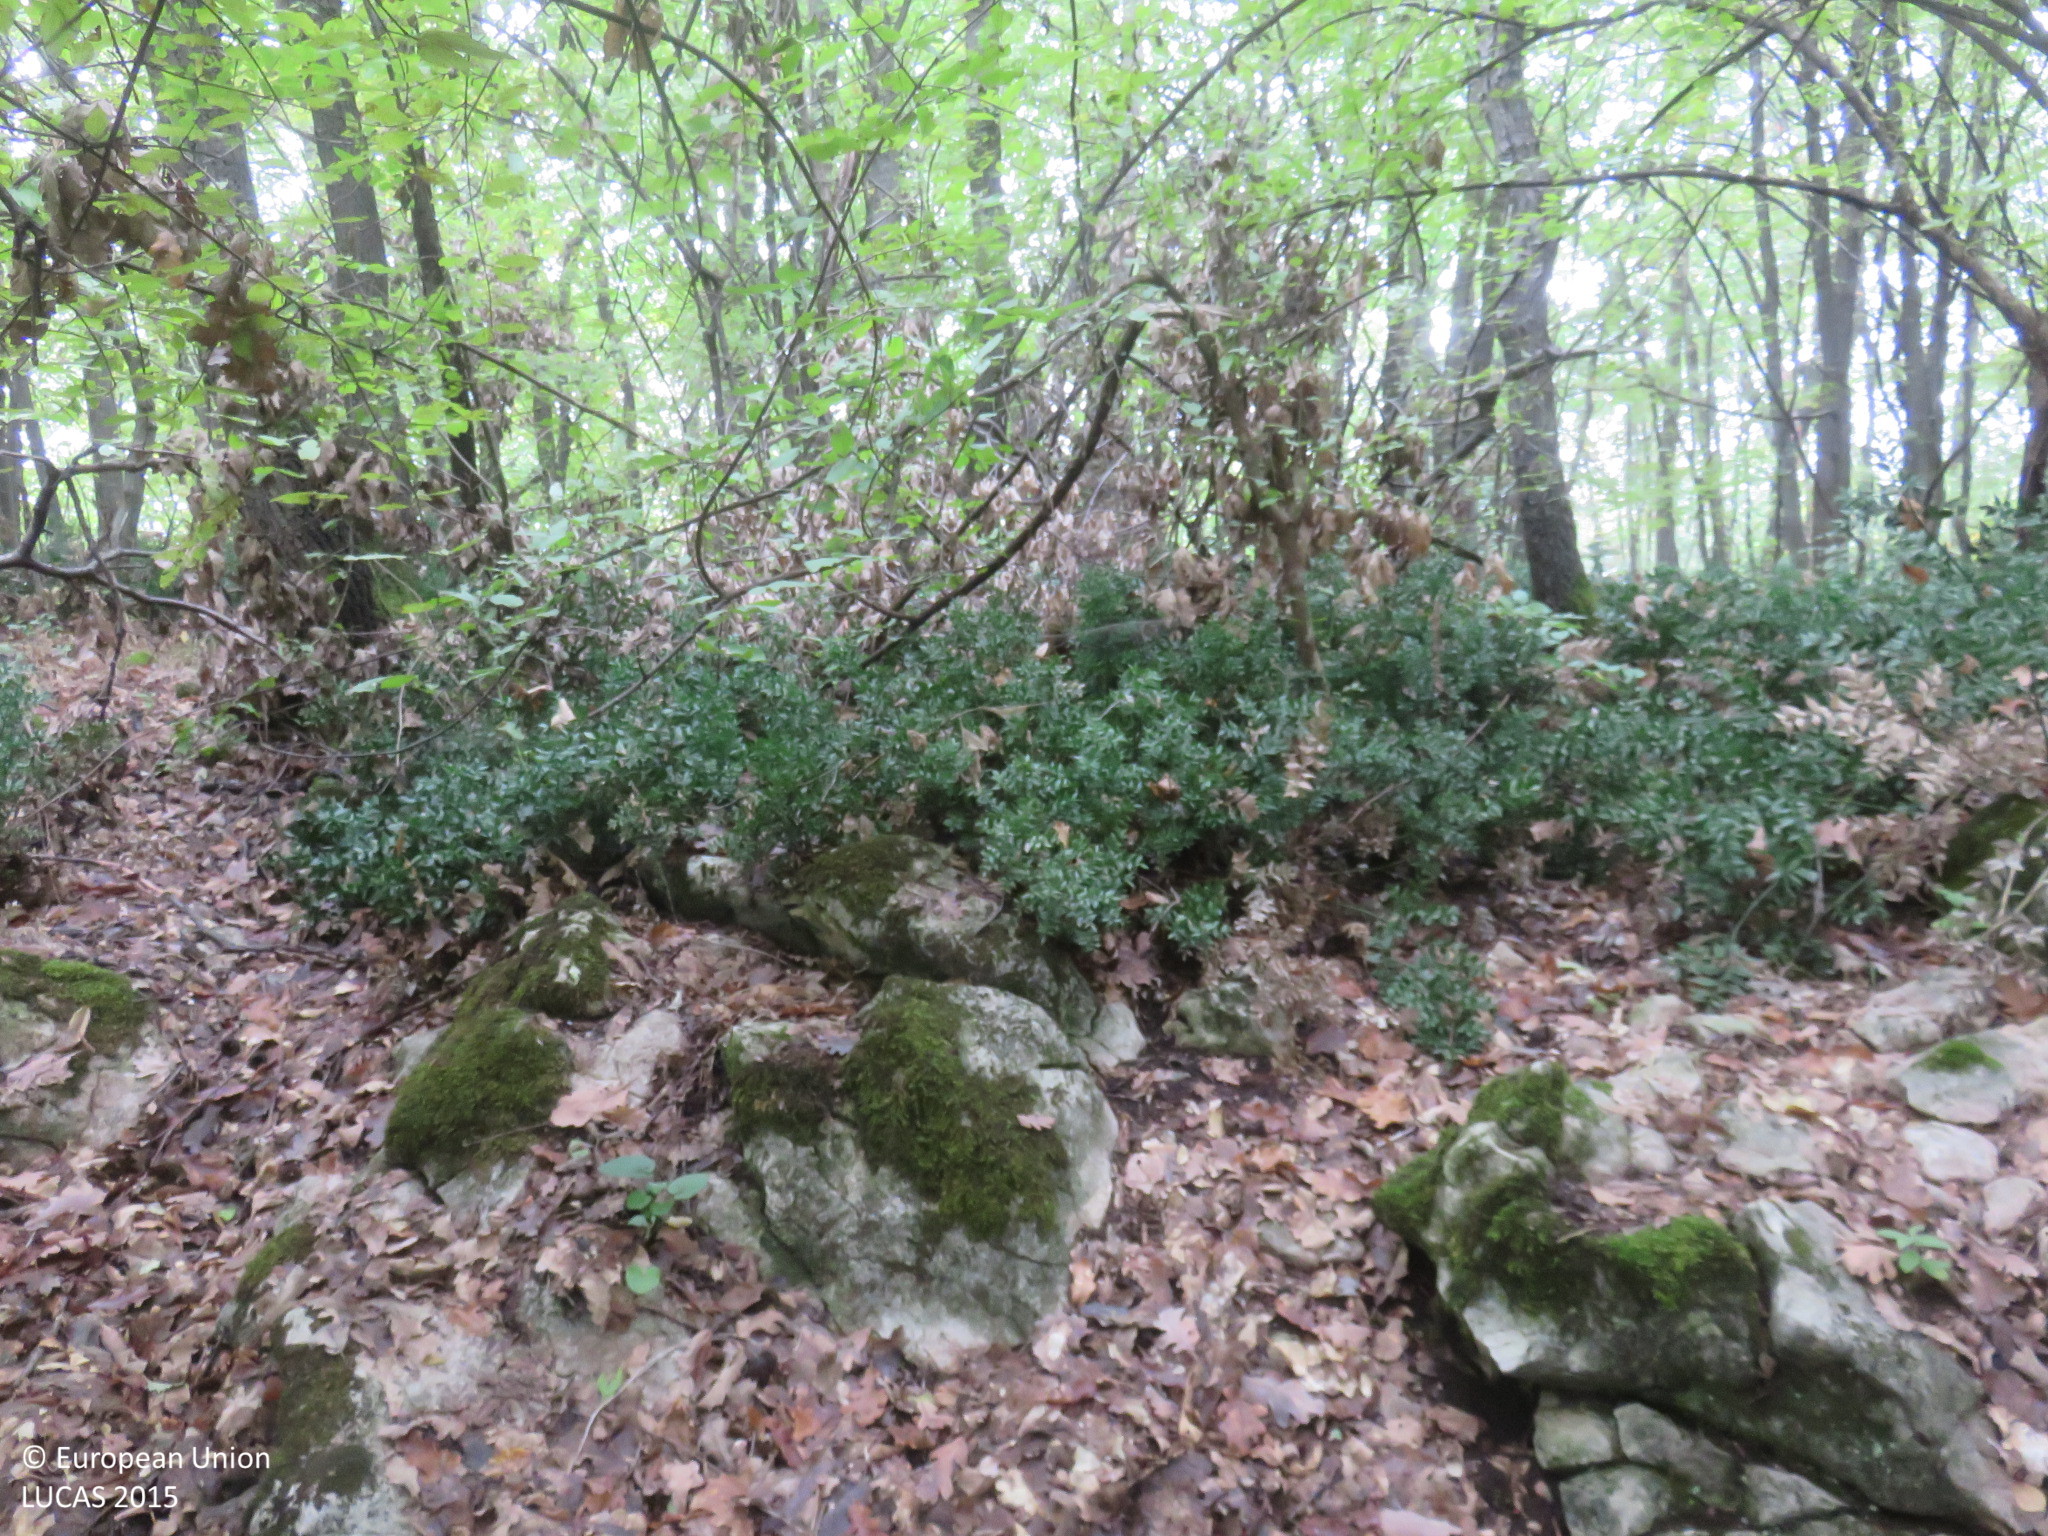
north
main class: Woodland
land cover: Broadleaved woodland
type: mesophytic deciduous forest
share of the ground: > 75 %
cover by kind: broadleaved forest trees 85 %, unconsolidated bare surface 10 %, herbaceous plants 5 %
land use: Forestry
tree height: > 5 m
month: October
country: BG
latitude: 42.9793
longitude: 25.1141
